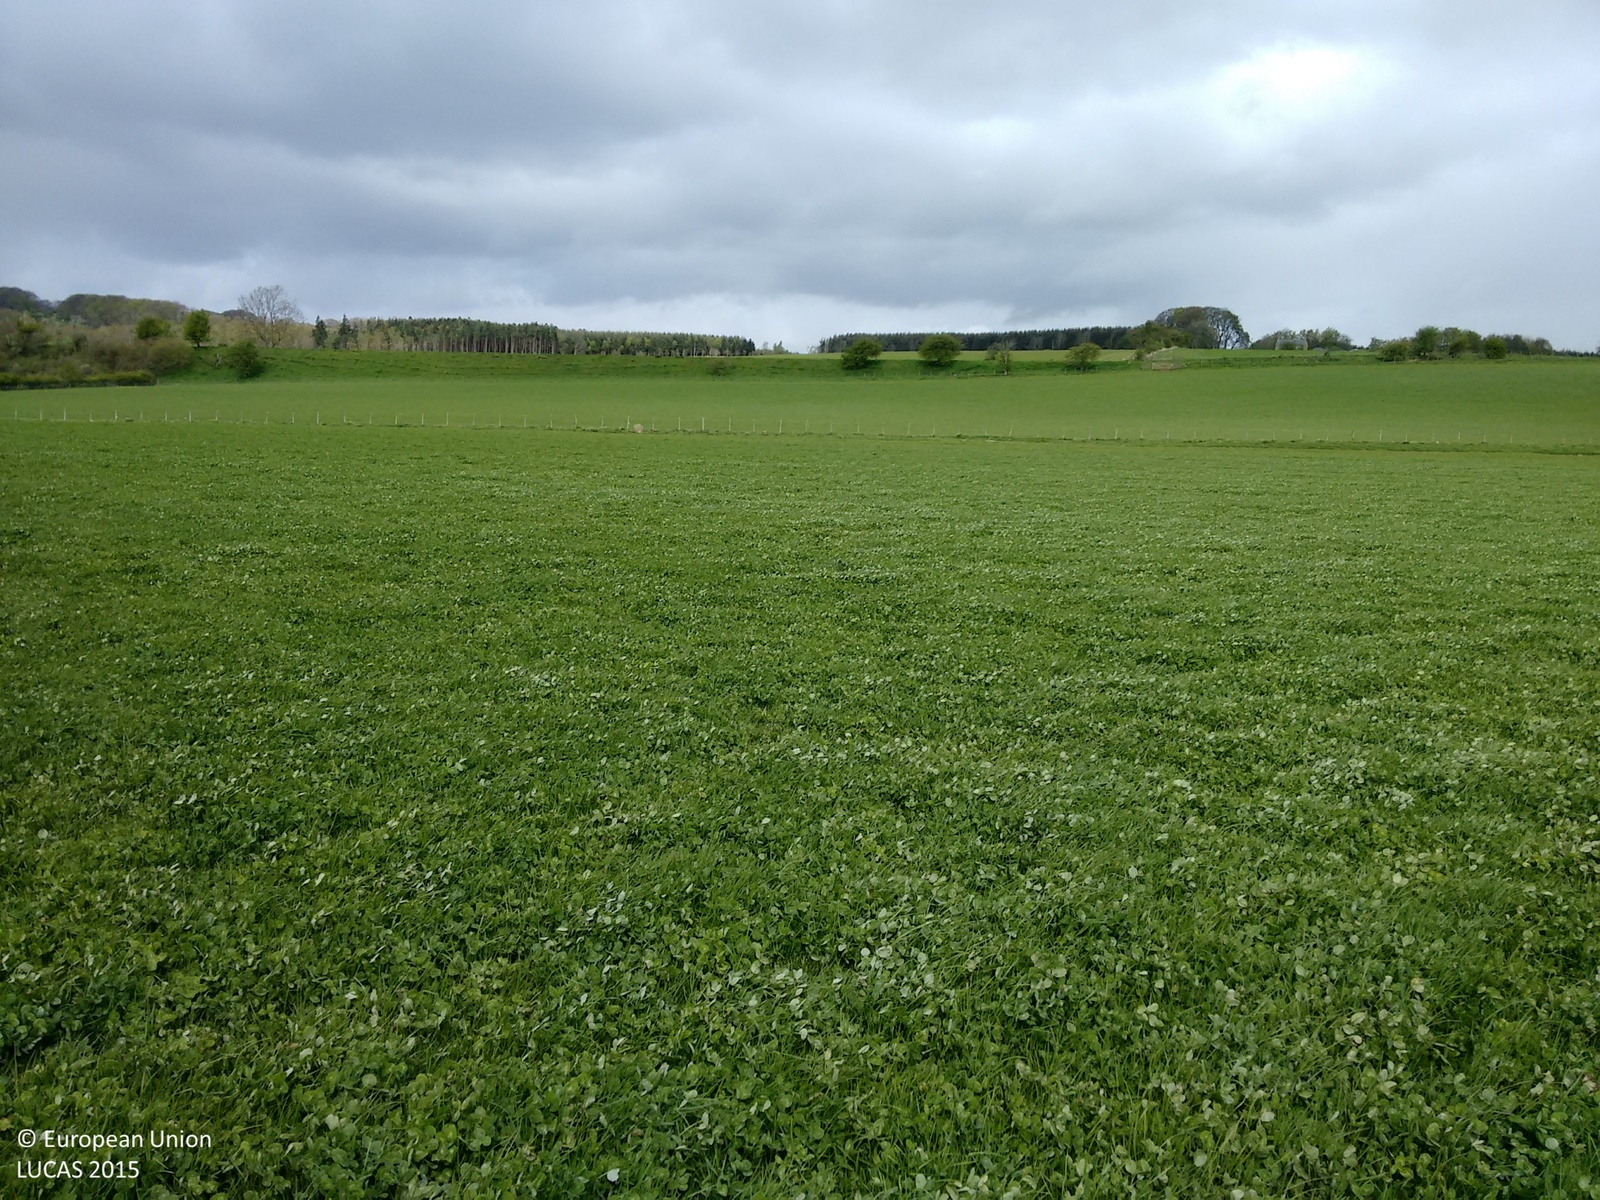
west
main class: Cropland
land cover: Clovers
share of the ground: > 75 %
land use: Agriculture (excluding fallow land and kitchen gardens)
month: May
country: GB
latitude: 55.1908
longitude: -1.9439
